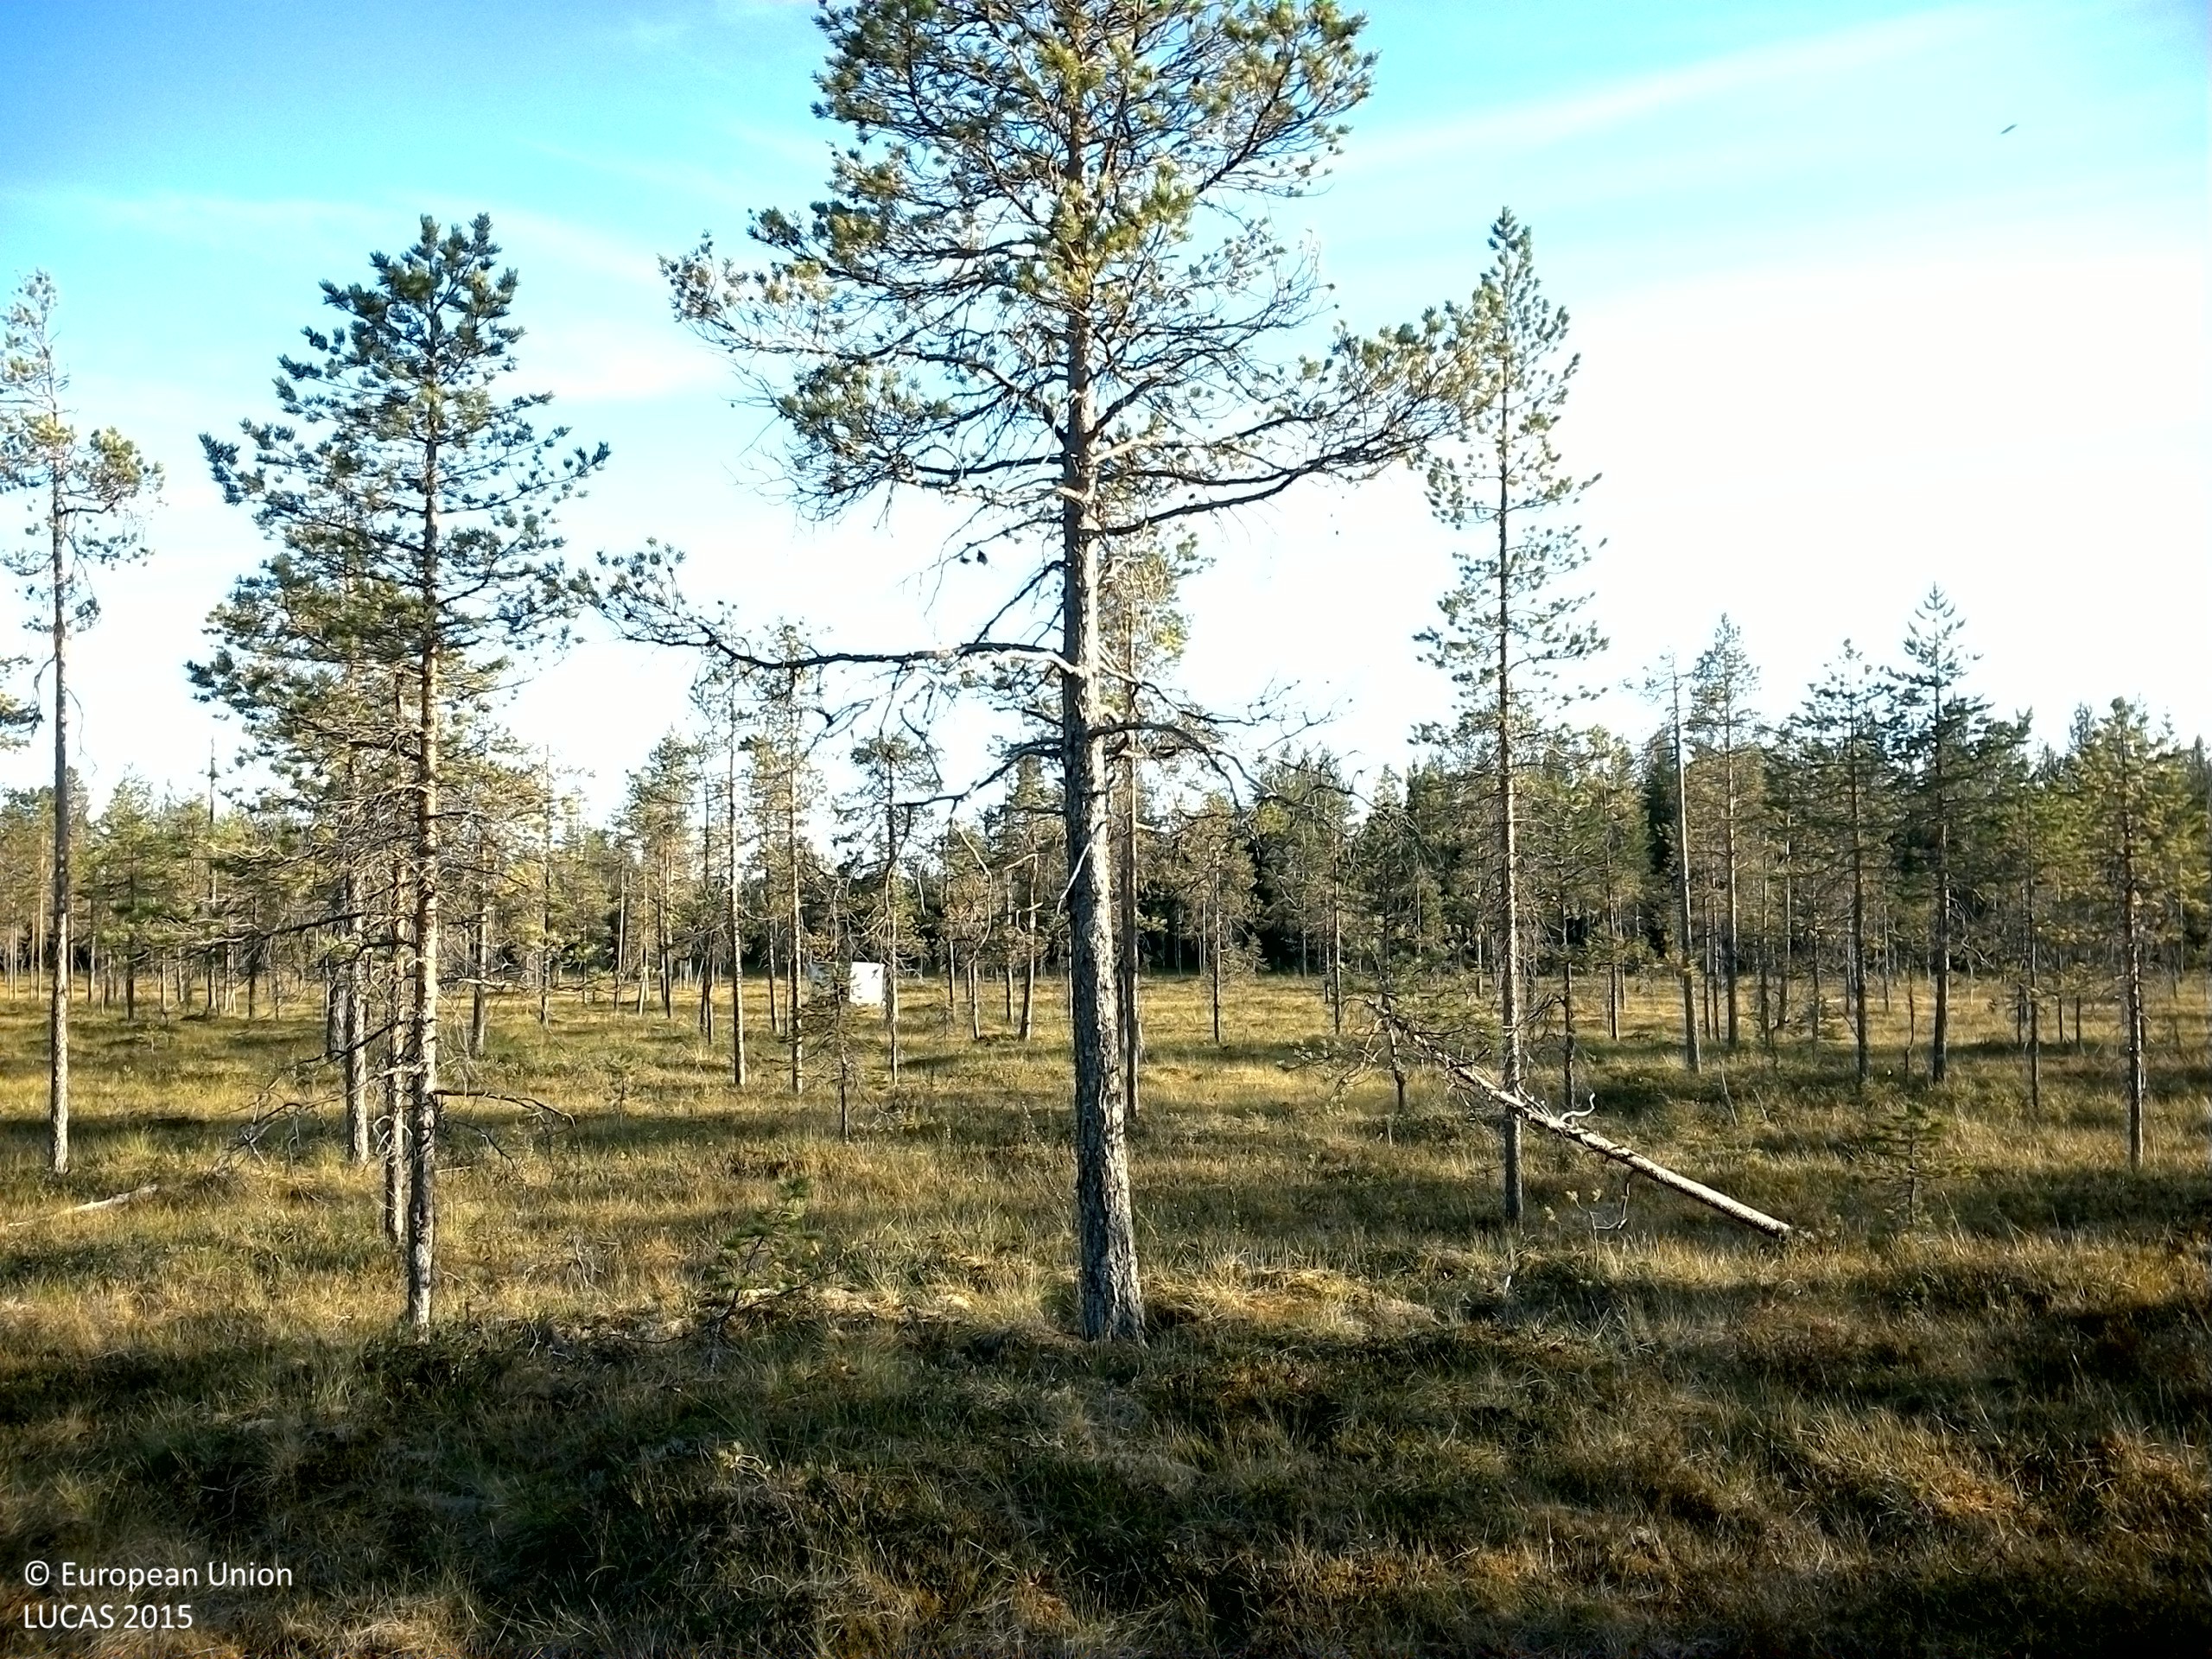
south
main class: Woodland
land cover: Pine dominated coniferous woodland
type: boreal forest
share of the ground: 10 - 25 %
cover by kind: shrubs 50 %, lichens and mosses 25 %, coniferous forest trees 15 %, herbaceous plants 10 %
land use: Semi-natural and natural areas not in use
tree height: < 5 m
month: August
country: SE
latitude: 63.6857
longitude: 18.0410
